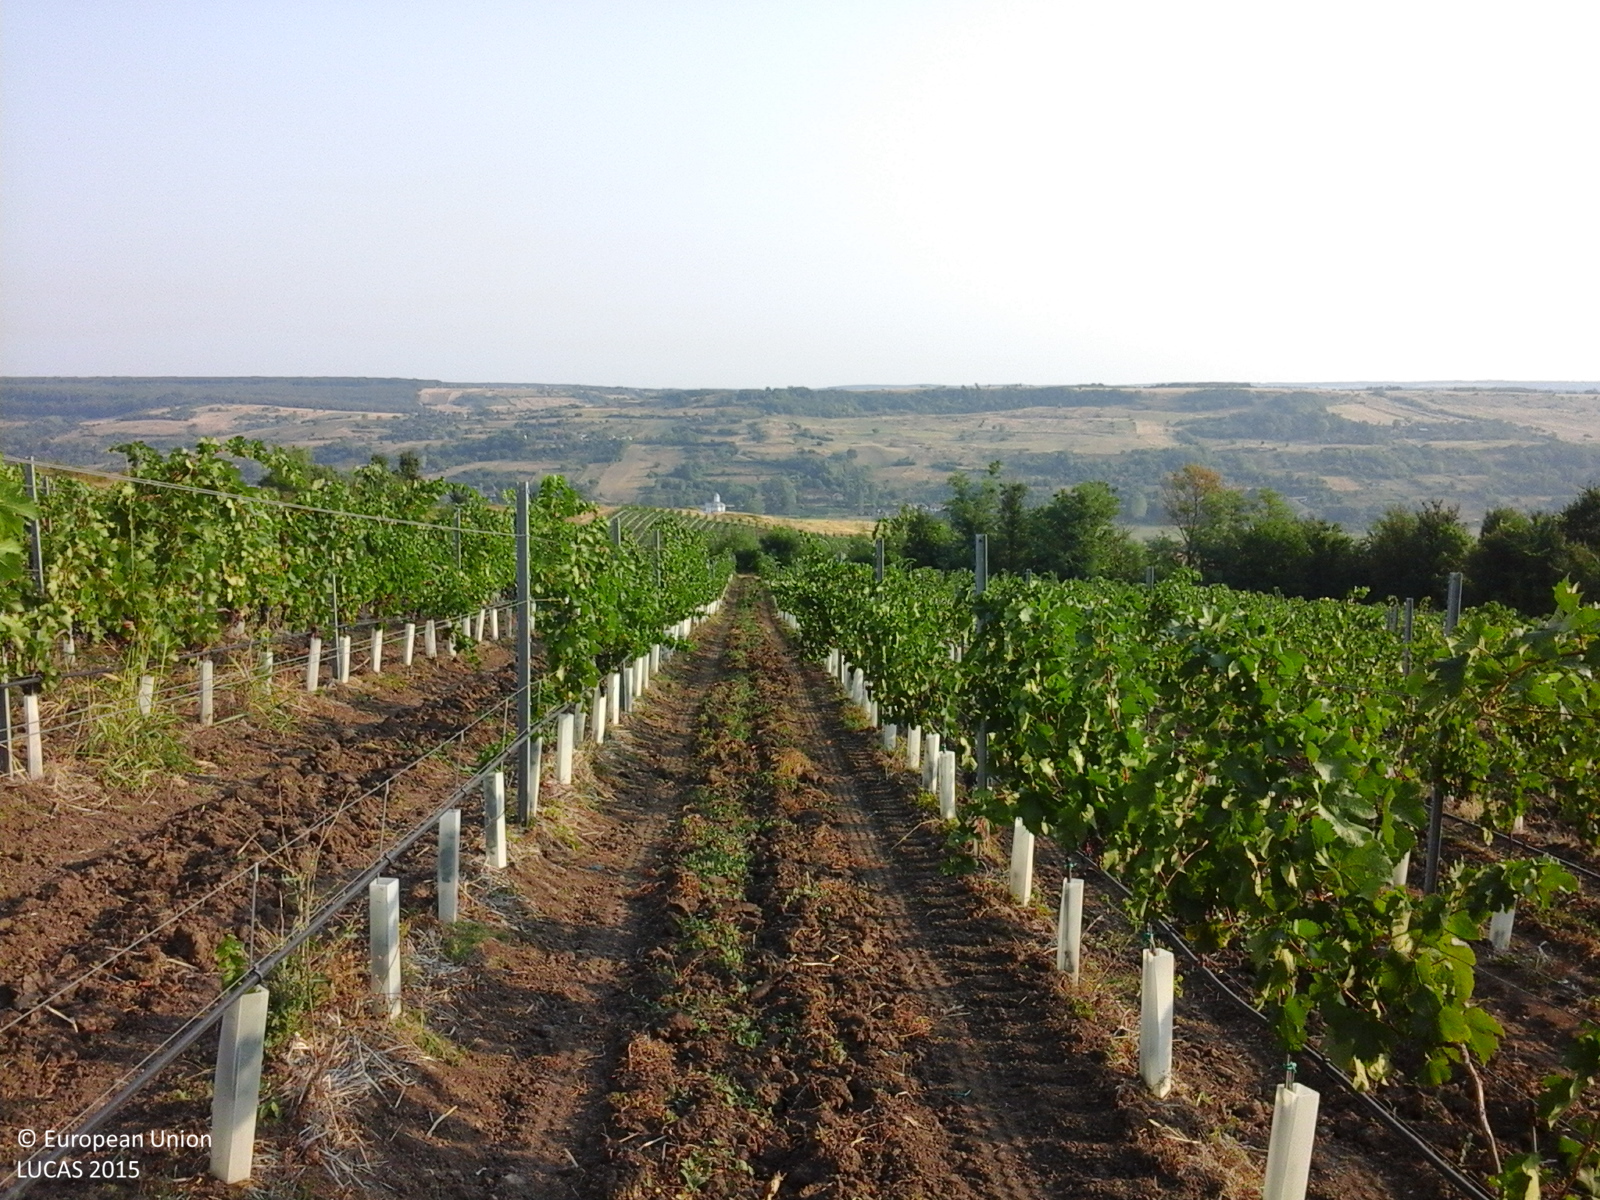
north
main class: Cropland
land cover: Vineyards
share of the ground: 25 - 50 %
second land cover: Other bare soil
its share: > 75 %
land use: Agriculture (excluding fallow land and kitchen gardens)
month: August
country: RO
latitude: 44.4921
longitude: 23.3172
